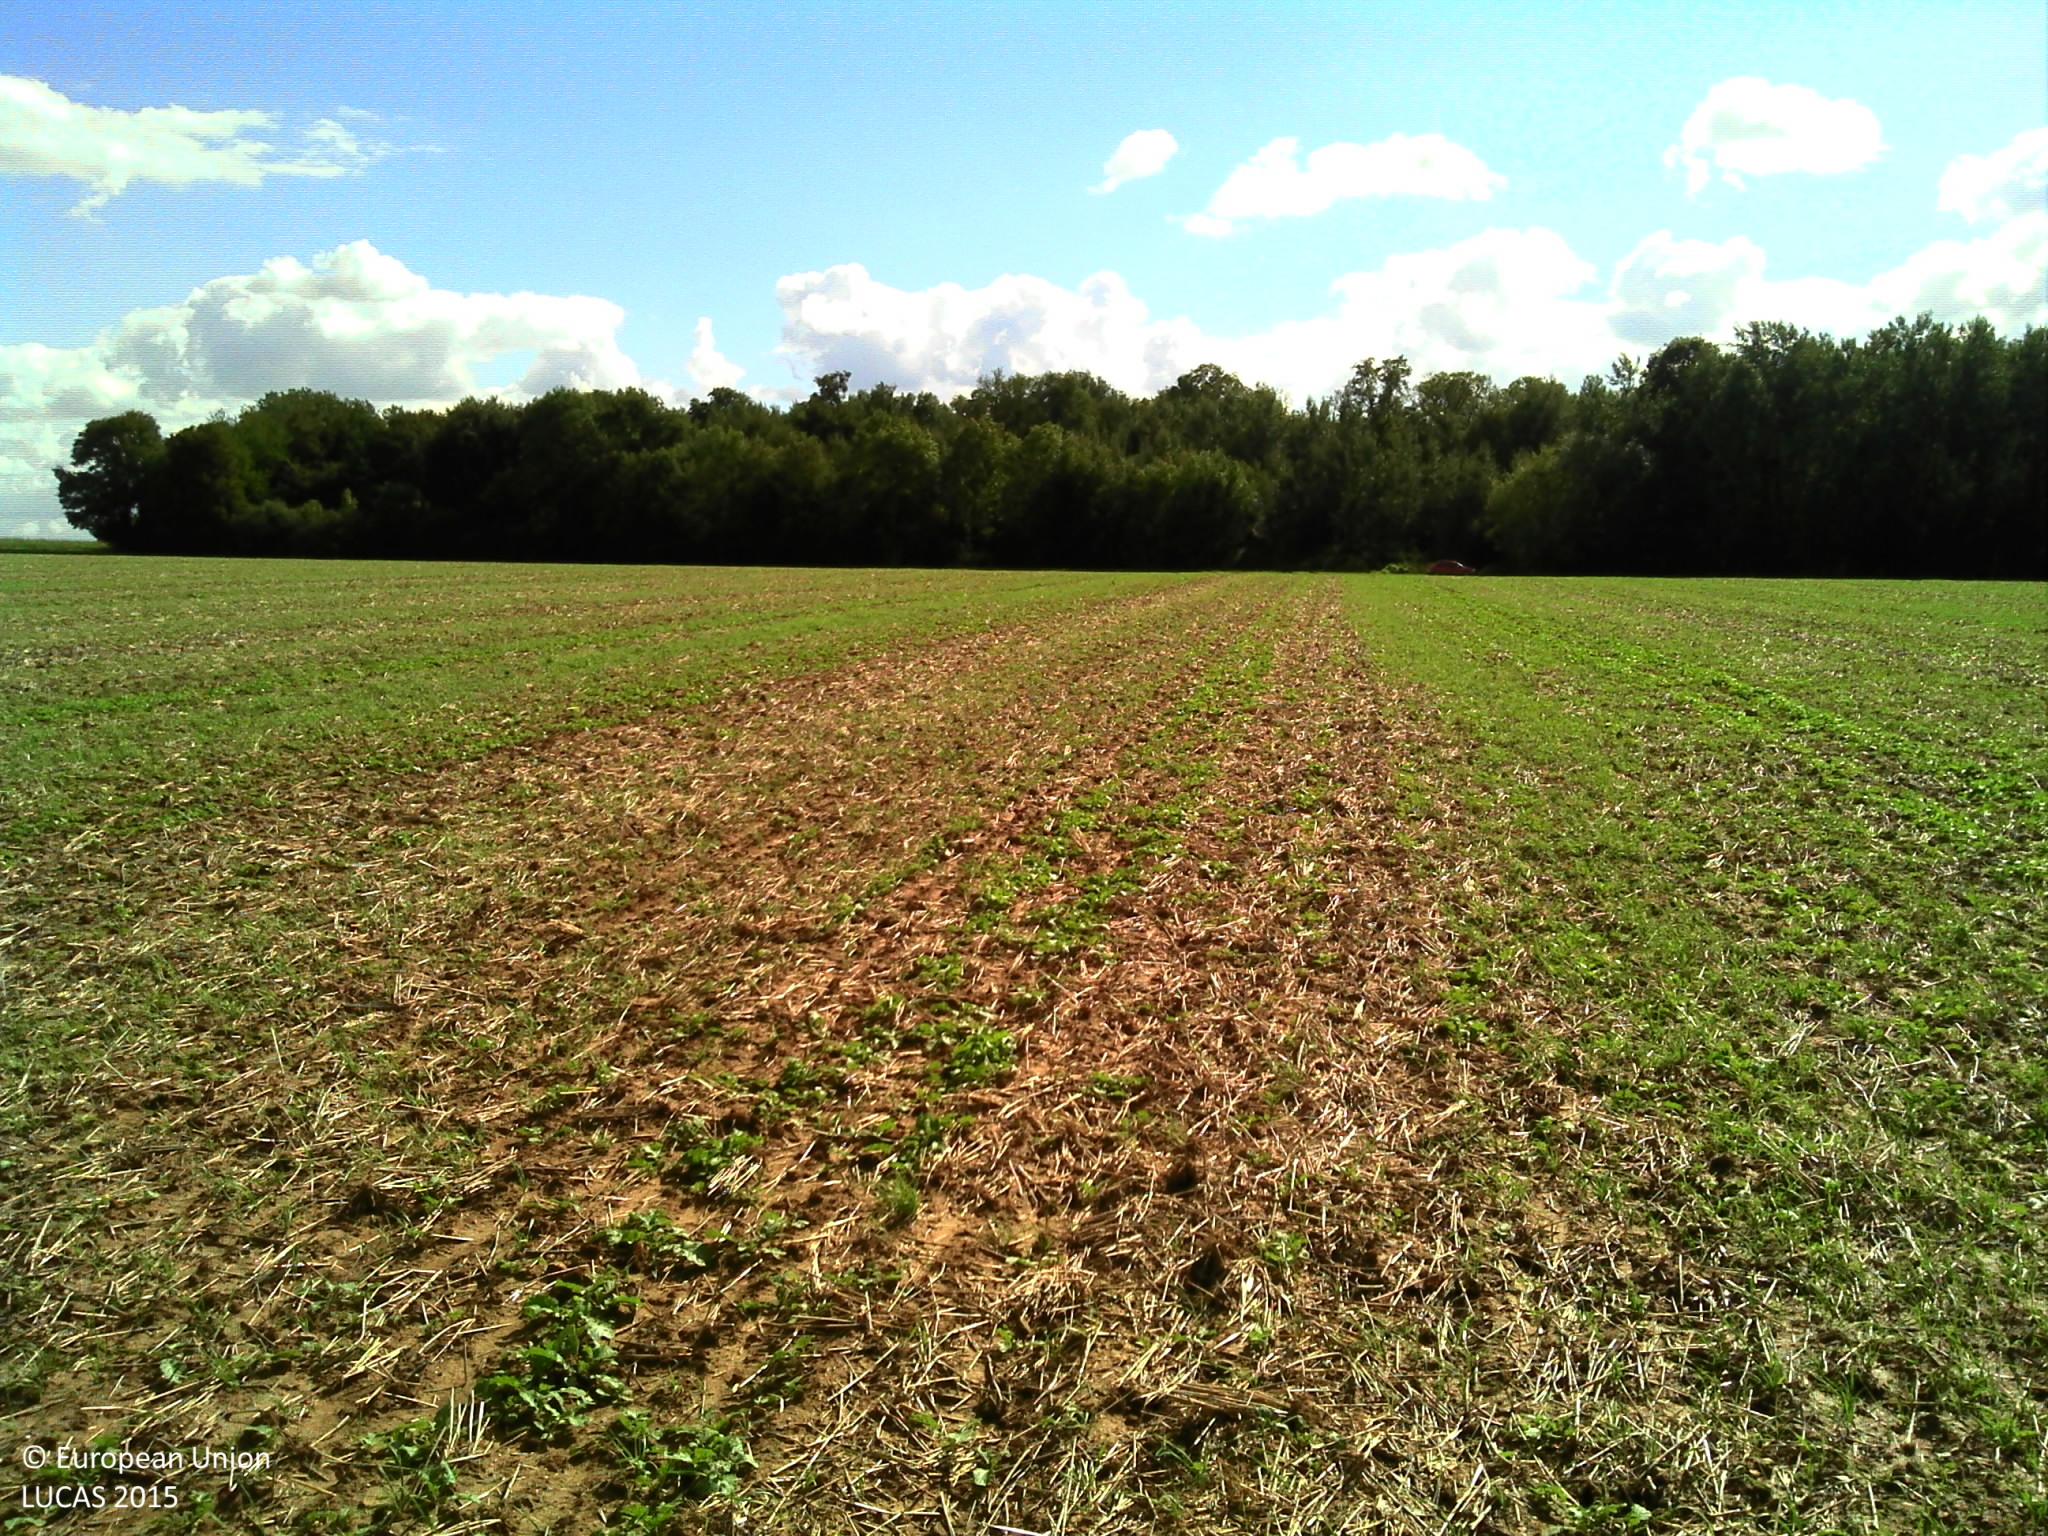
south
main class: Cropland
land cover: Common wheat
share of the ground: < 10 %
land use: Agriculture (excluding fallow land and kitchen gardens)
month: September
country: FR
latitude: 48.5454
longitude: 3.0430
